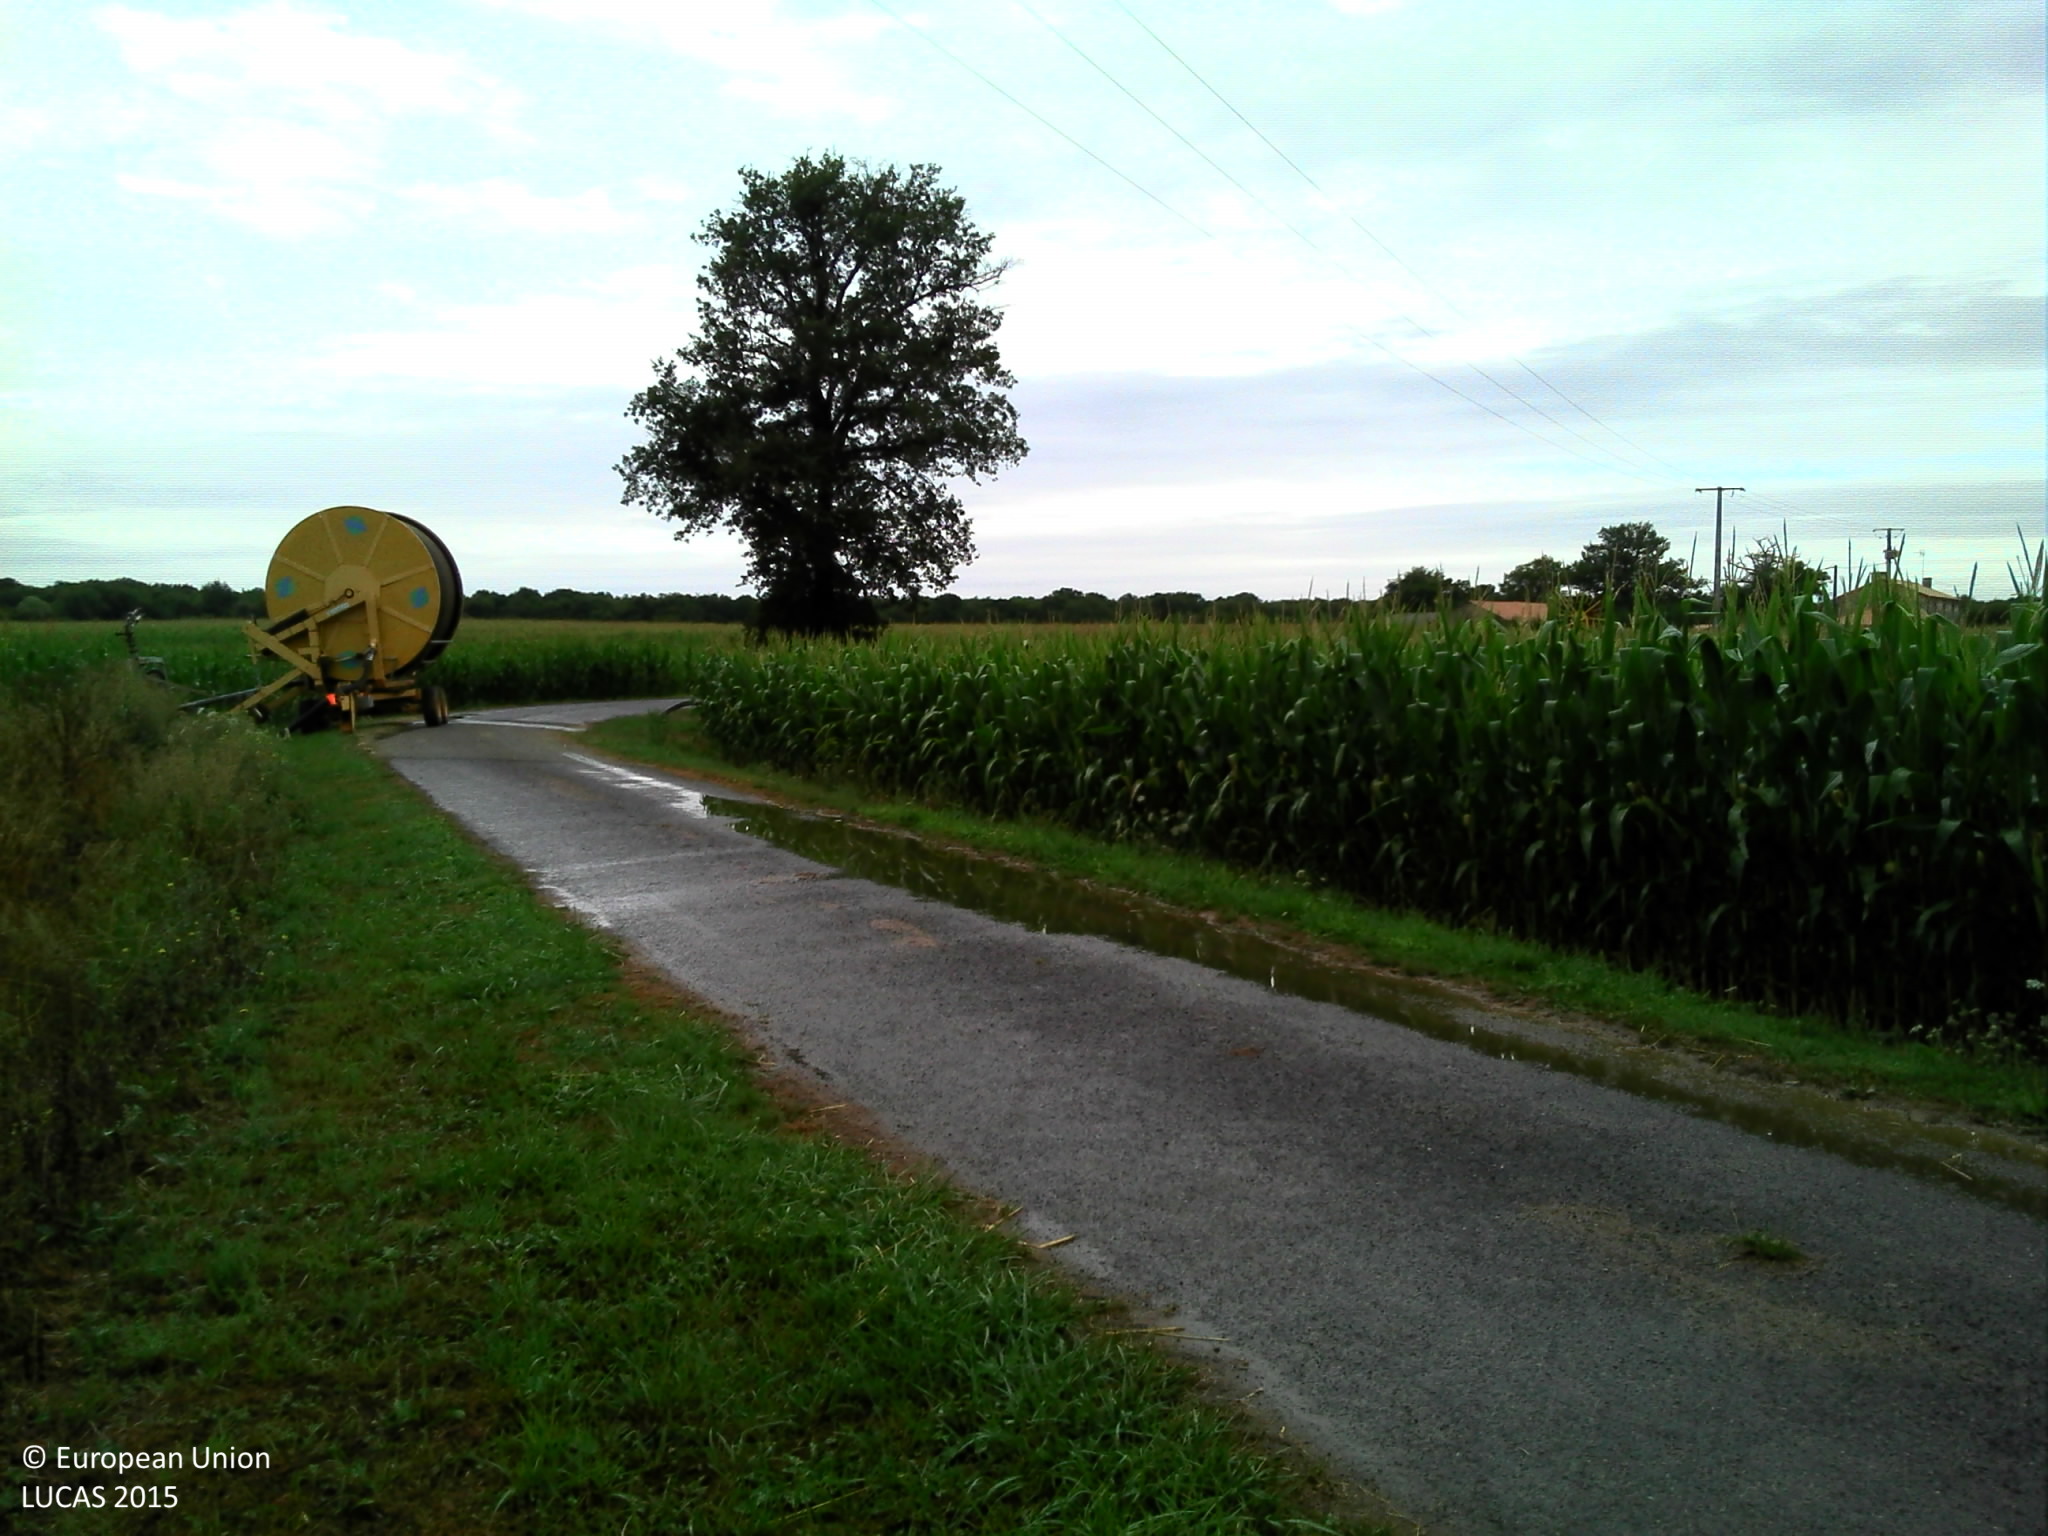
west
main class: Cropland
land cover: Maize
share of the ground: > 75 %
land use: Agriculture (excluding fallow land and kitchen gardens)
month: July
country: FR
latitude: 46.3679
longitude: 0.5594
